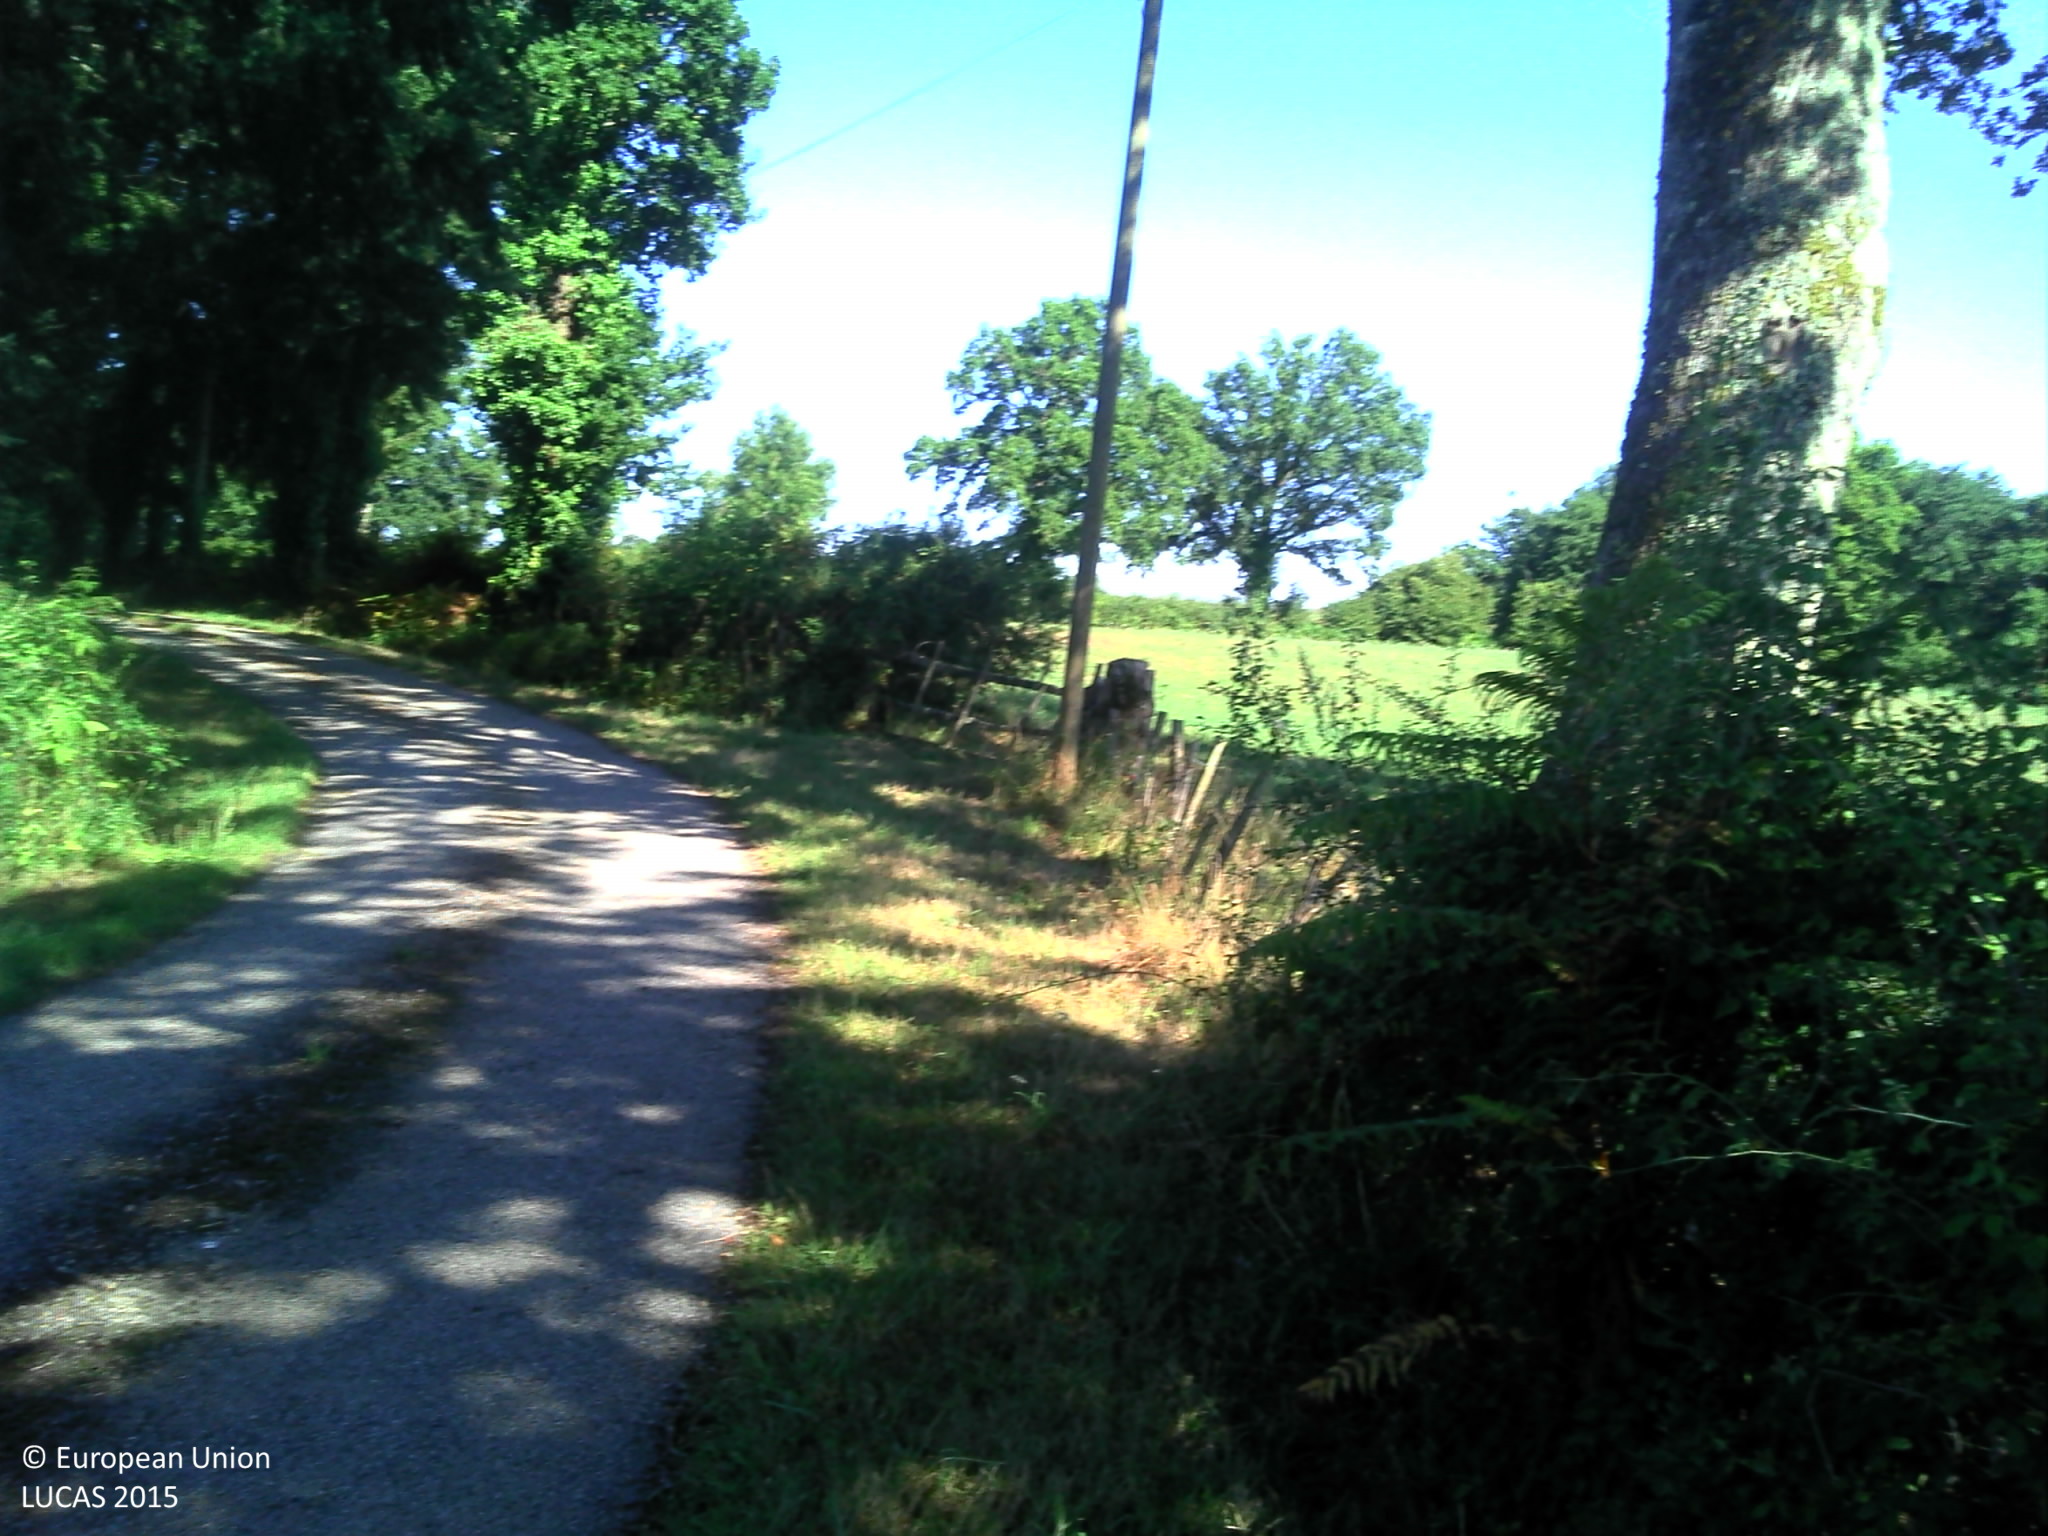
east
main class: Grassland
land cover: Grassland without tree/shrub cover
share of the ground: > 75 %
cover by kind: herbaceous plants 100 %
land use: Agriculture (excluding fallow land and kitchen gardens)
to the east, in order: Grass margins; Lines of trees; Fences; Grassland without tree/shrub cover; Fences; Managed hedges; Ditches and canals; Grass margins; Paved roads, cycling and walking lanes; Grass margins; Ditches and canals; Managed hedges; Fences; Grassland without tree/shrub cover; Fences; Groves; Grassland without tree/shrub cover
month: August
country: FR
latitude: 46.1470
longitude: 0.9376
